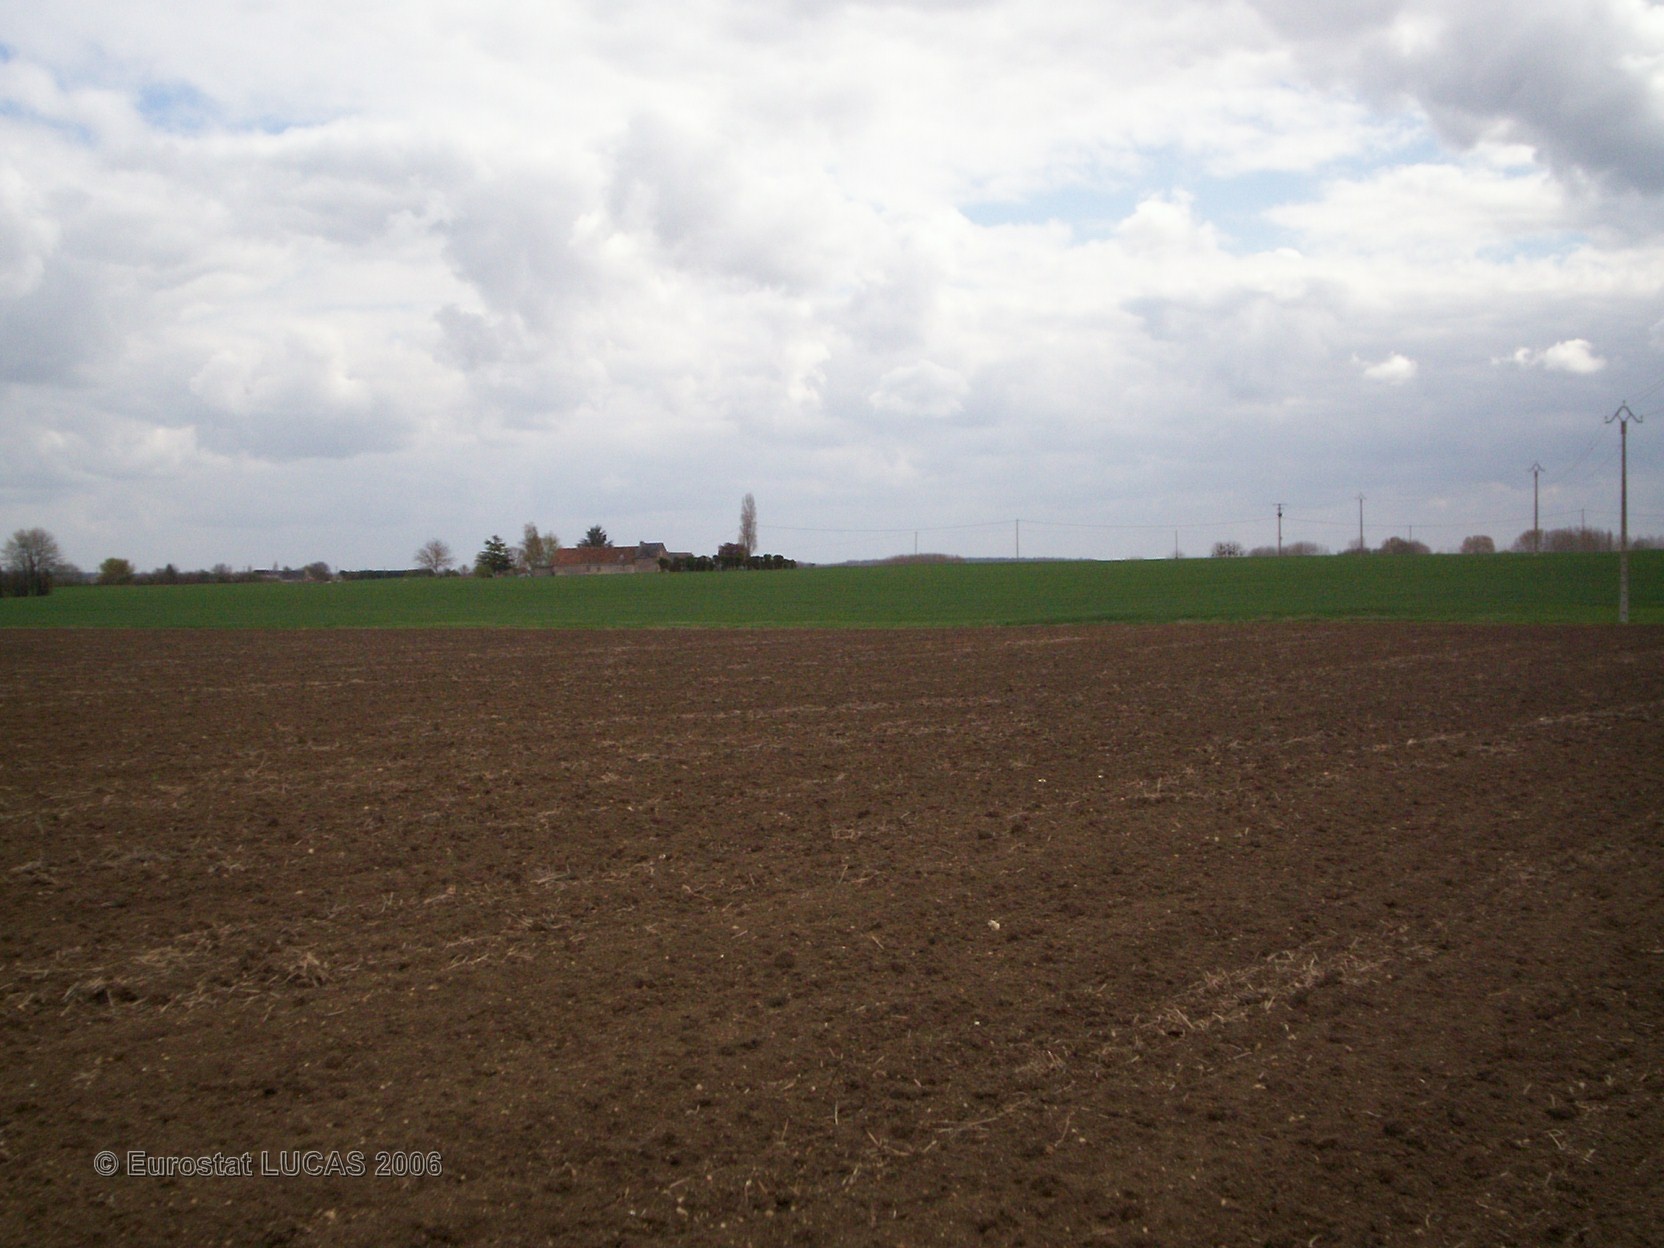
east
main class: Cropland
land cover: Sunflower
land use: Agriculture (excluding fallow land and kitchen gardens)
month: May
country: FR
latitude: 47.5154
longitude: 0.2158
